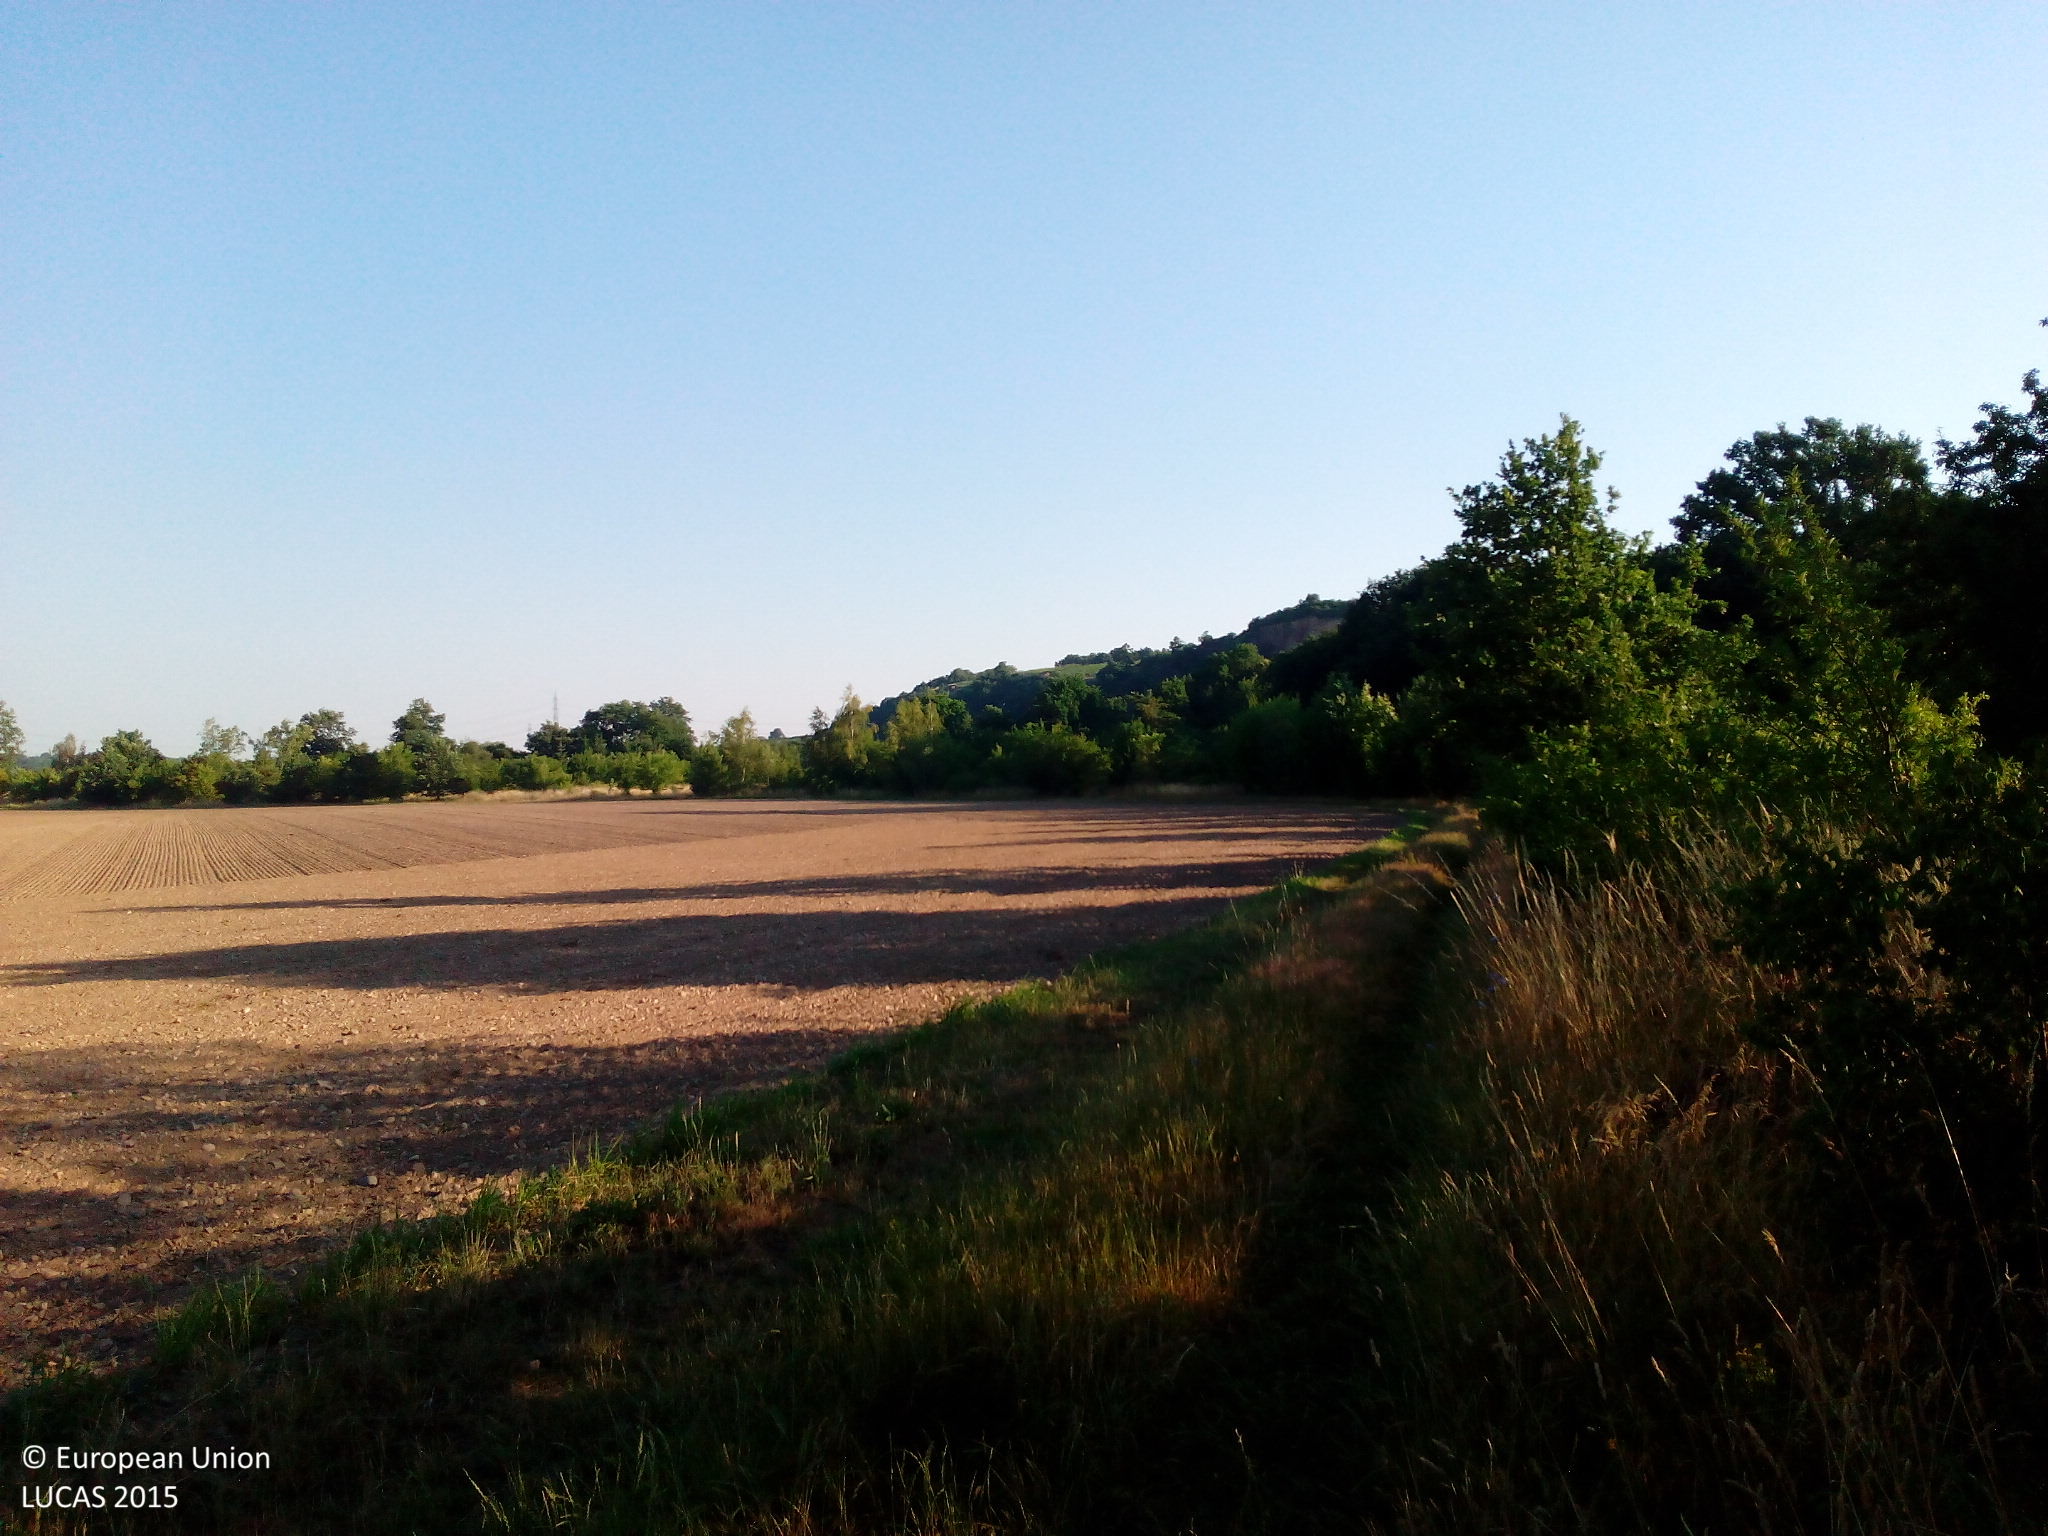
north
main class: Shrubland
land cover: Shrubland with sparse tree cover
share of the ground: > 75 %
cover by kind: shrubs 70 %, herbaceous plants 25 %, broadleaved forest trees 5 %
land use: Agriculture (excluding fallow land and kitchen gardens)
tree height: > 5 m
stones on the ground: < 10 %
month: July
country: DE
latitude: 51.2306
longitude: 13.4231
